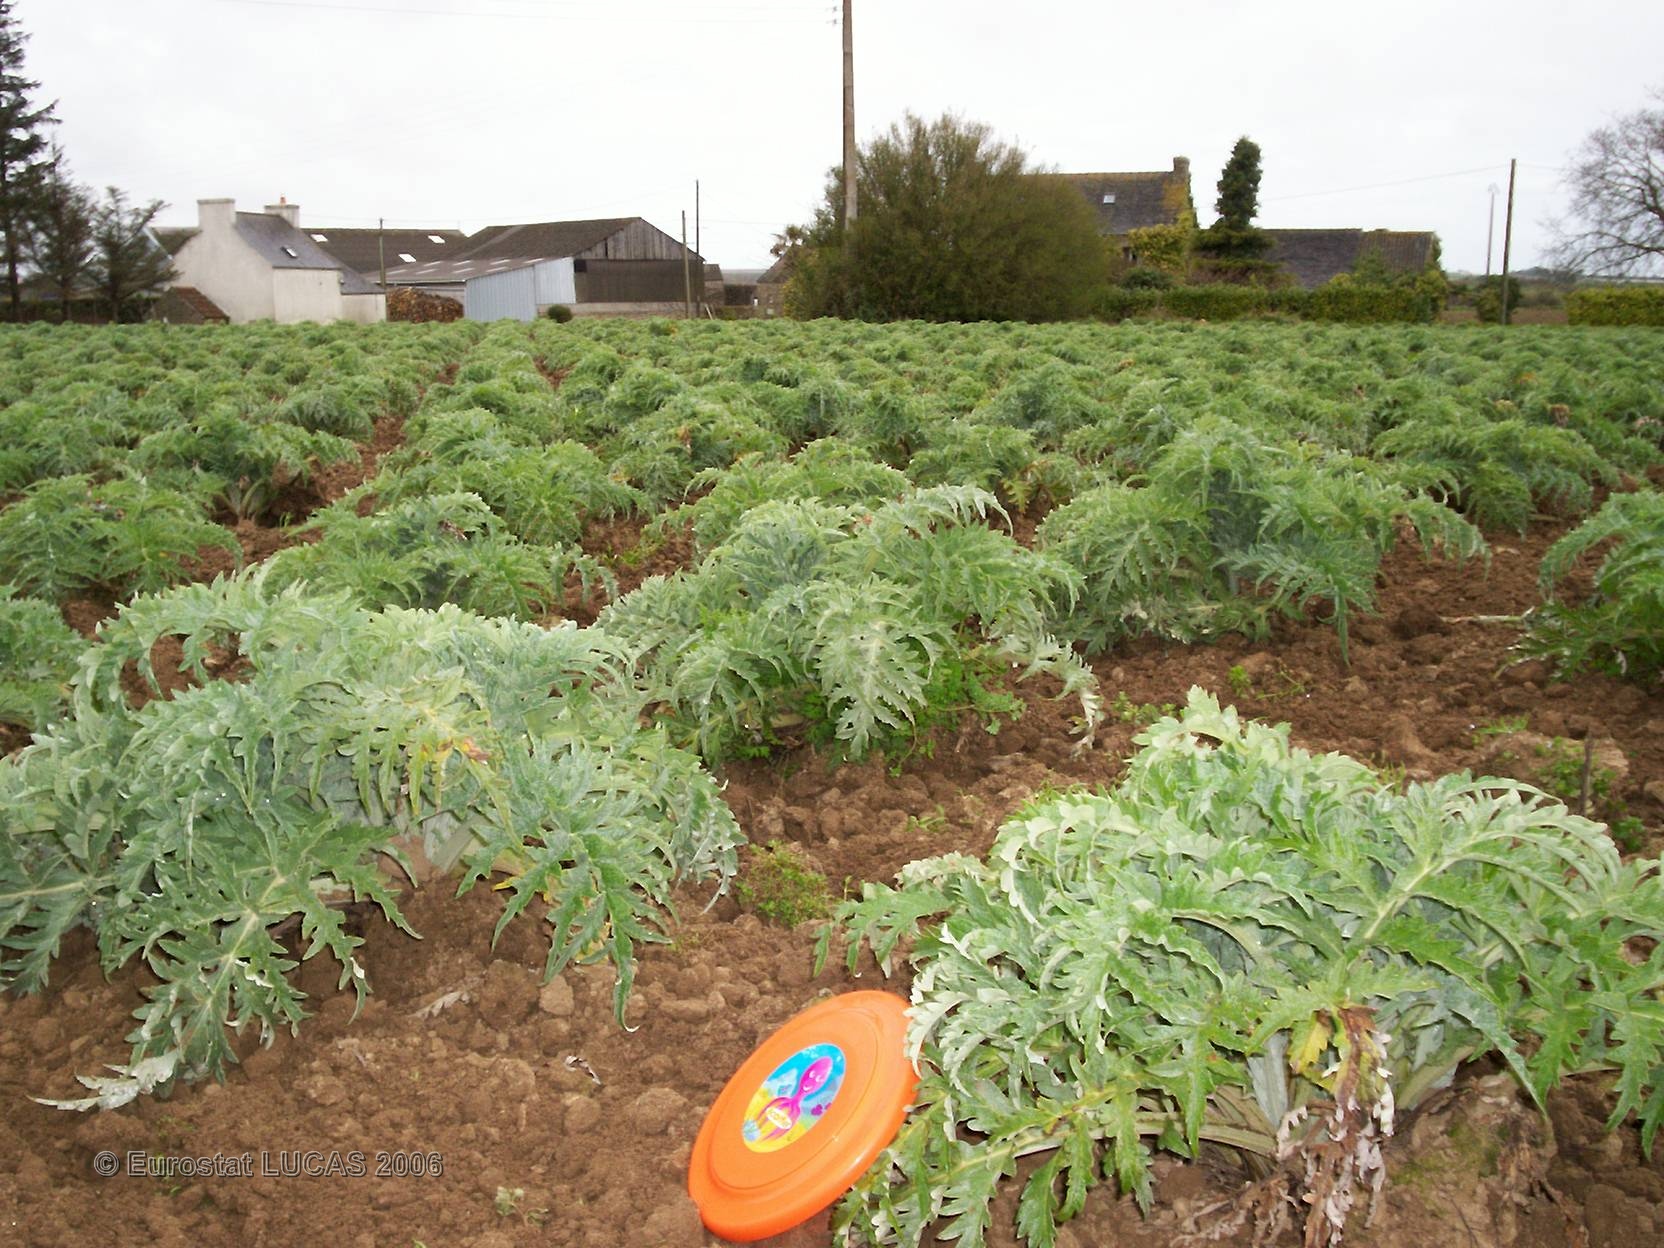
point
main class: Cropland
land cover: Other fresh vegetables
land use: Agriculture (excluding fallow land and kitchen gardens)
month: April
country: FR
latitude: 48.6326
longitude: -4.0529
